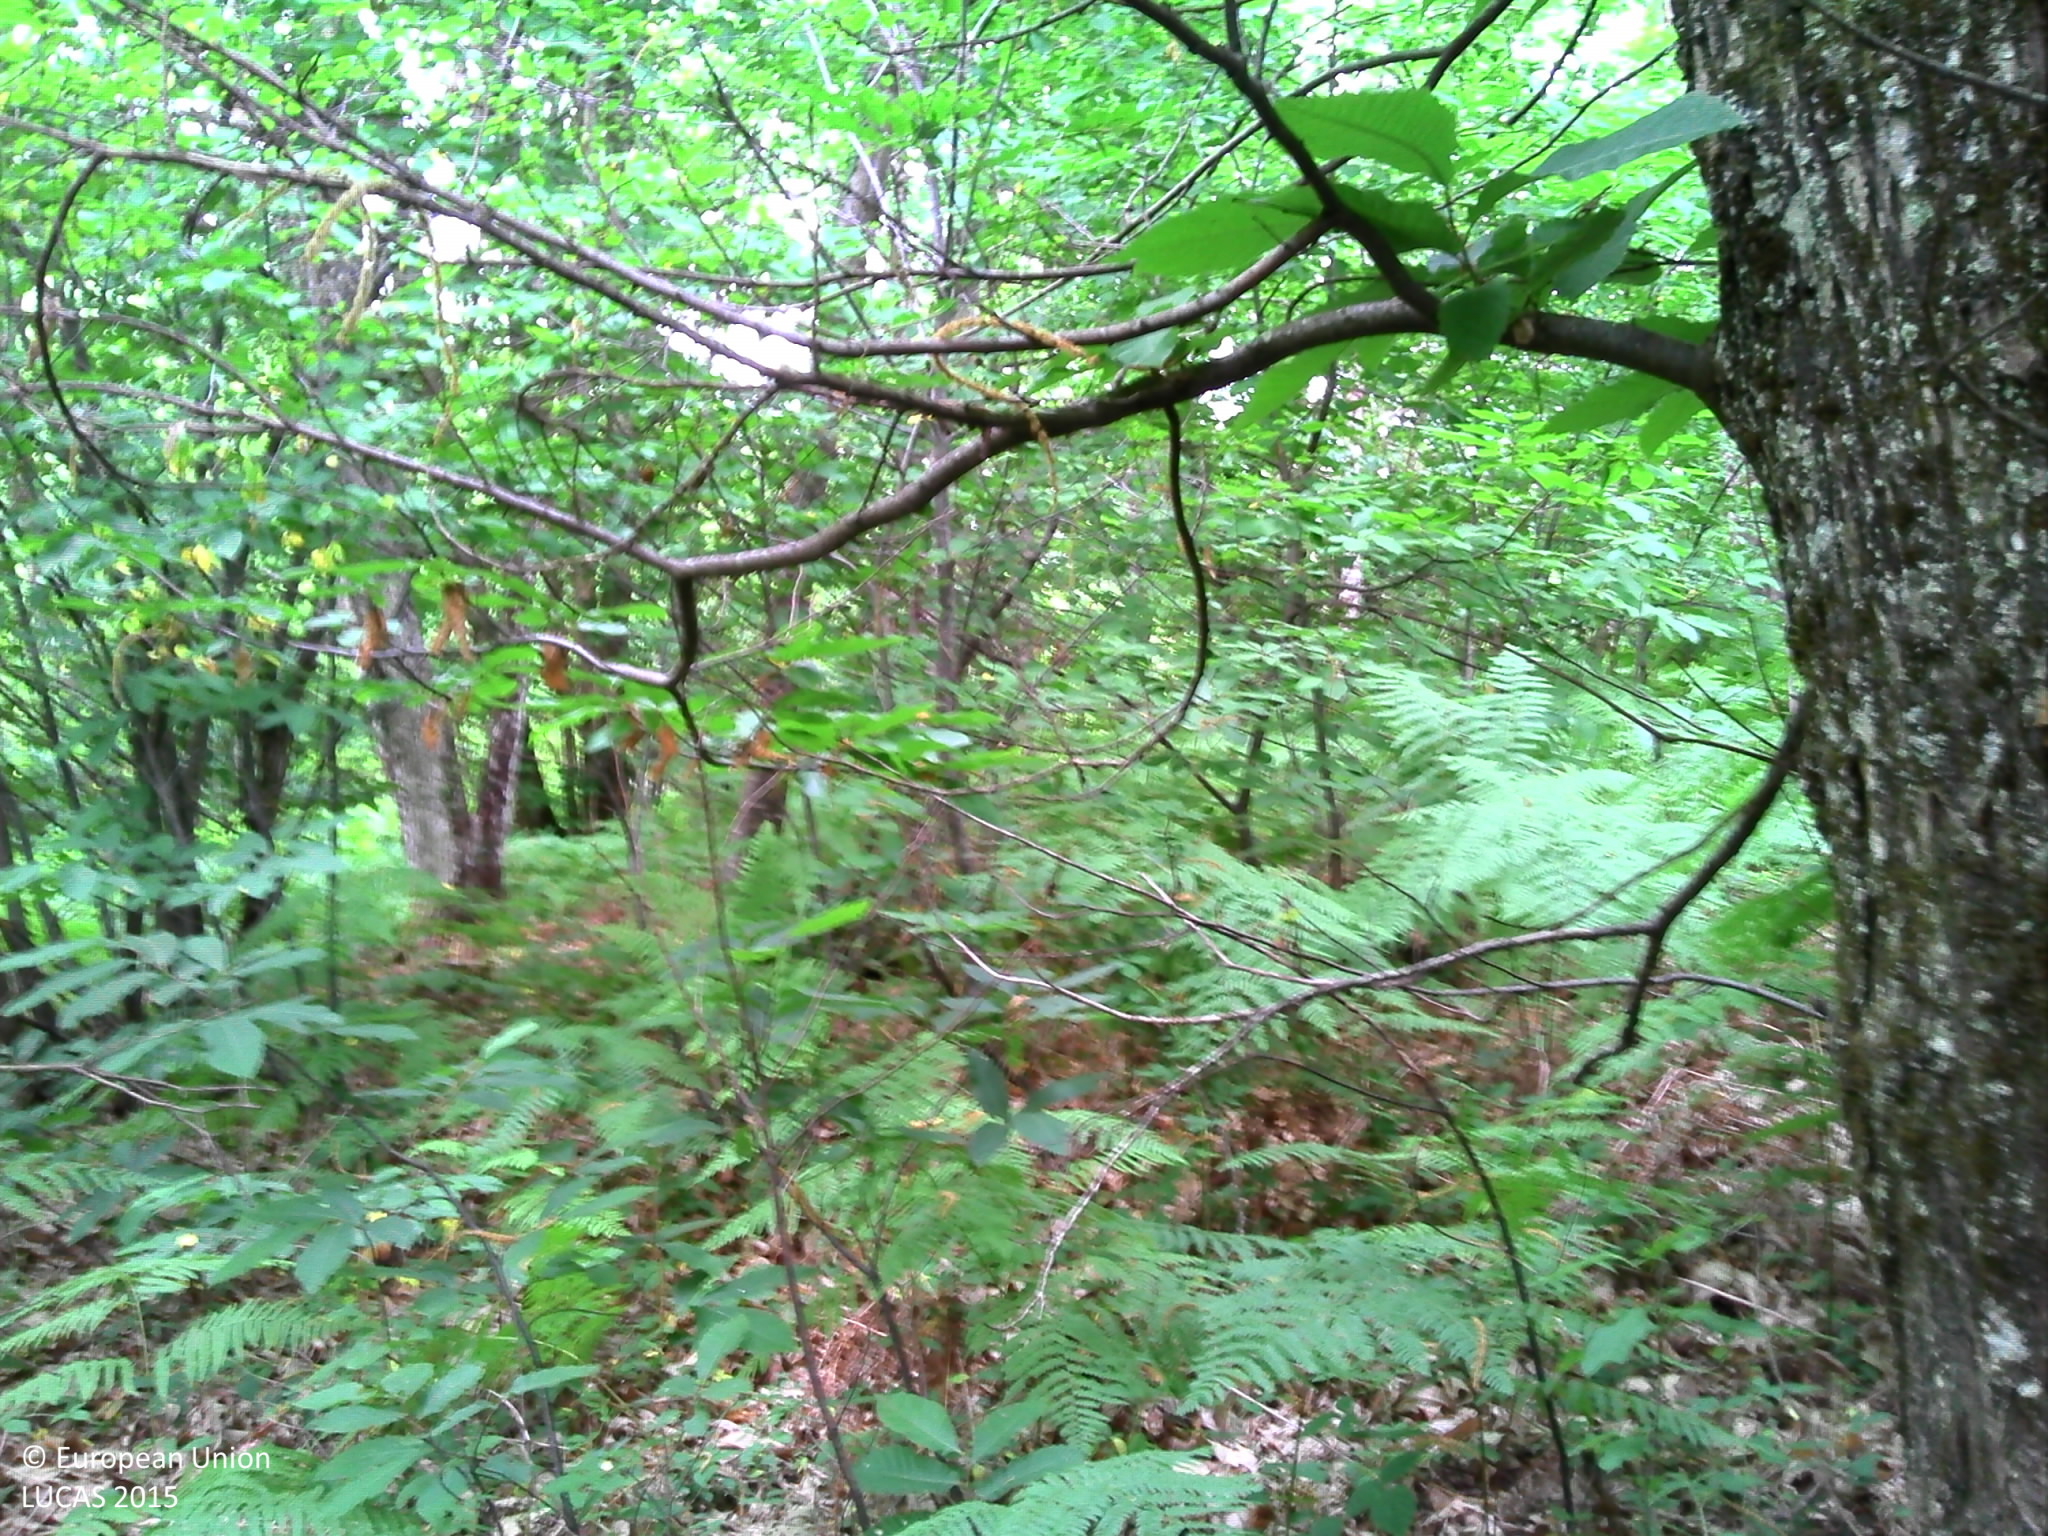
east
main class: Woodland
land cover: Broadleaved woodland
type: thermophilous deciduous forest
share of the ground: > 75 %
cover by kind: broadleaved forest trees 80 %, herbaceous plants 15 %, shrubs 5 %
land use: Forestry
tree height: > 5 m
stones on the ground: 10 - 25 %
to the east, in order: Broadleaved woodland; Ditches and canals; Grass margins; Tracks; Broadleaved woodland; Ditches and canals; Grass margins; Tracks; Grass margins
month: July
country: FR
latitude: 45.0978
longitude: 0.7525
